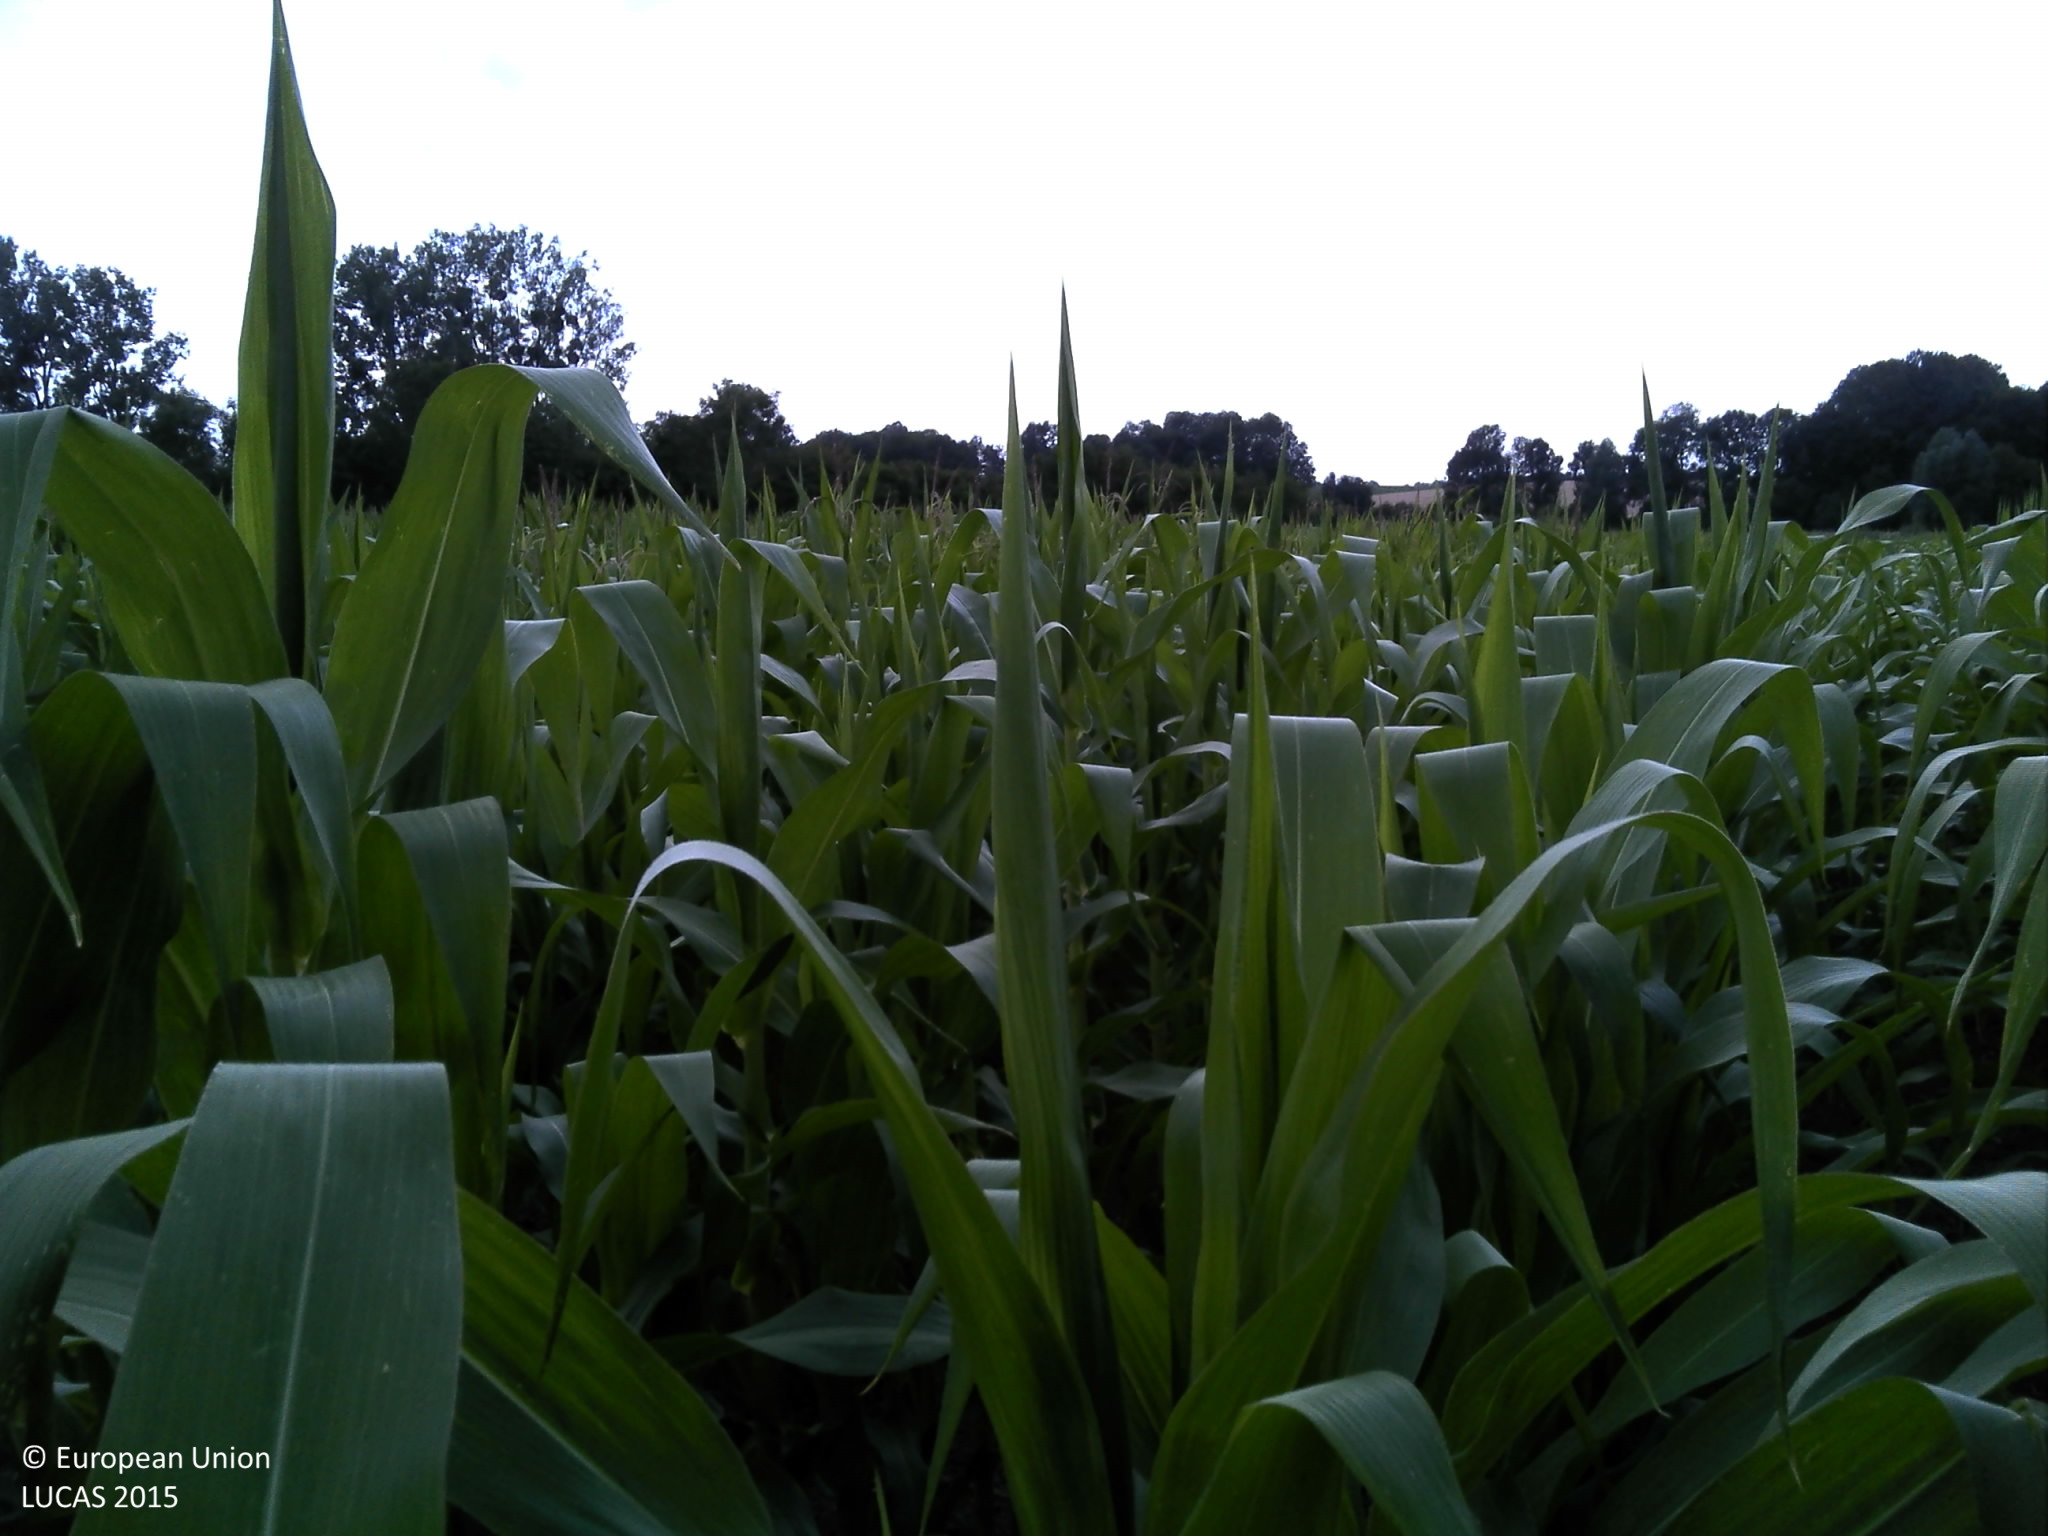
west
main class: Cropland
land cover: Maize
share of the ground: > 75 %
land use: Agriculture (excluding fallow land and kitchen gardens)
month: July
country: FR
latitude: 49.0056
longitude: 4.8712
